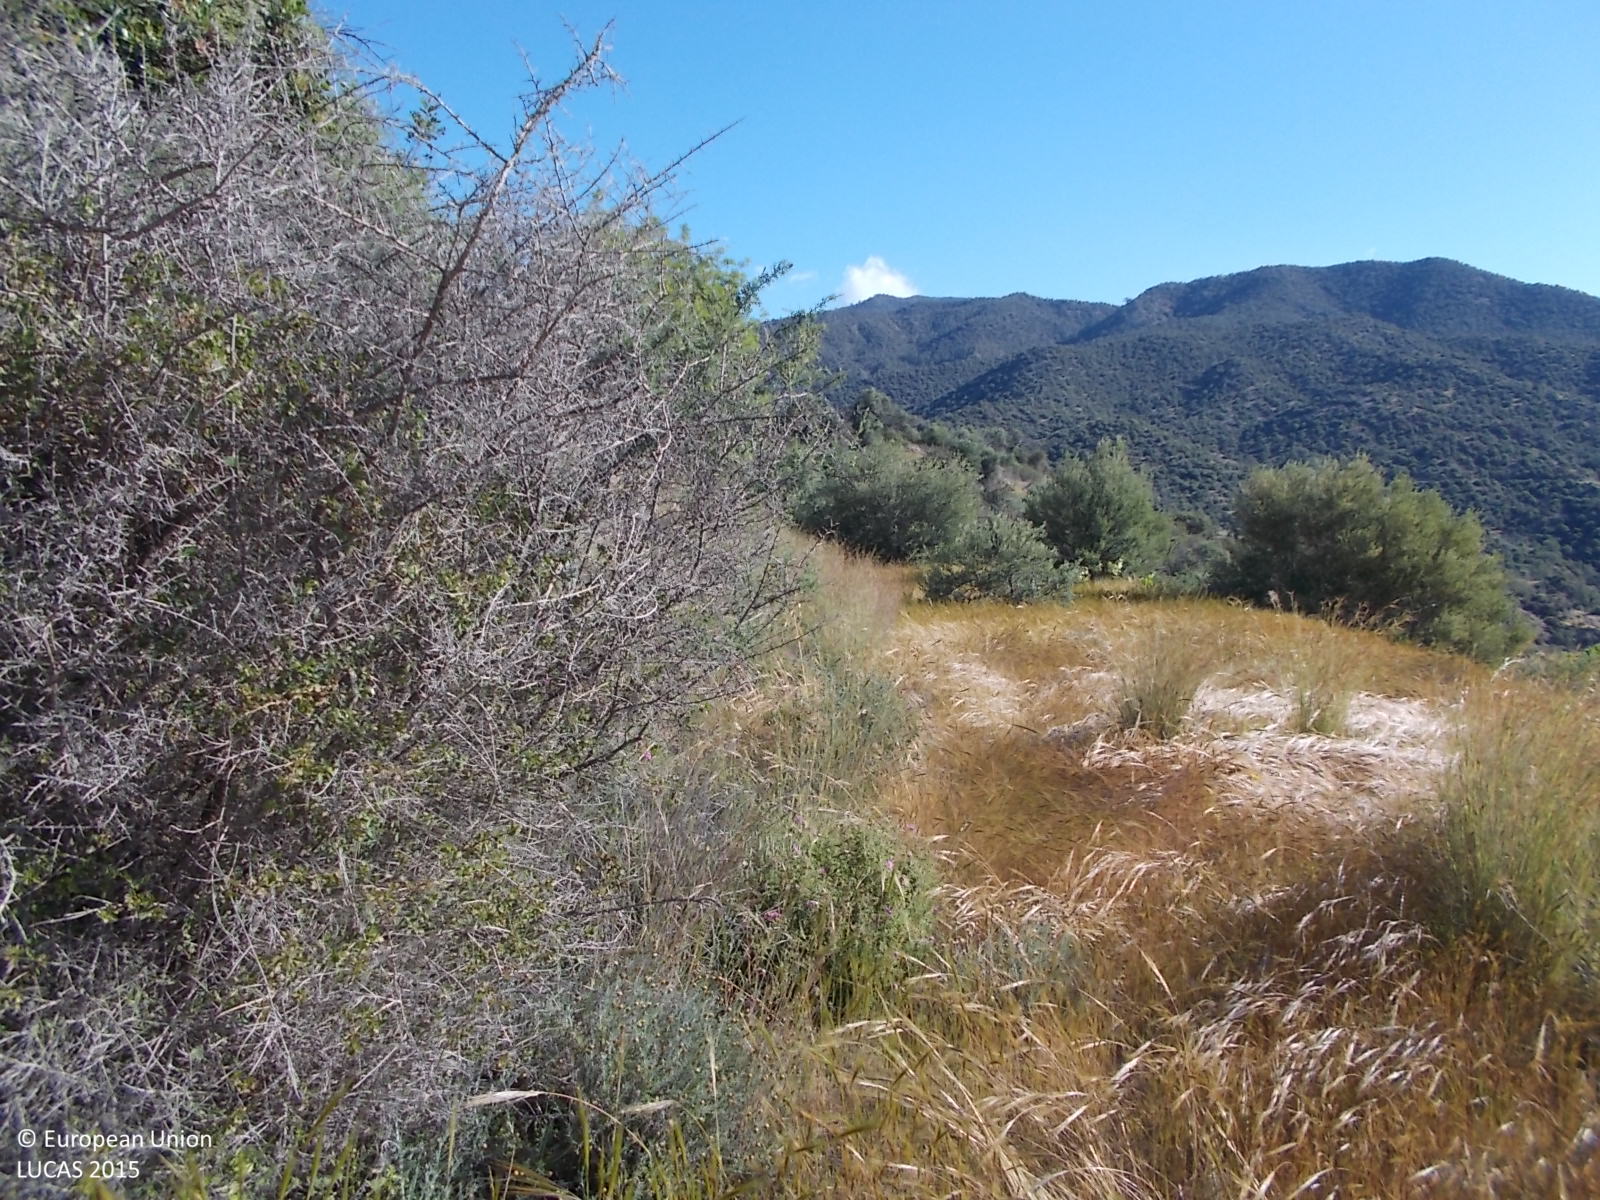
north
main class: Cropland
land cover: Olive groves
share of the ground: 25 - 50 %
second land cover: Grassland without tree/shrub cover
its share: > 75 %
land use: Abandoned areas
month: April
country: CY
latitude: 34.7782
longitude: 33.0616
